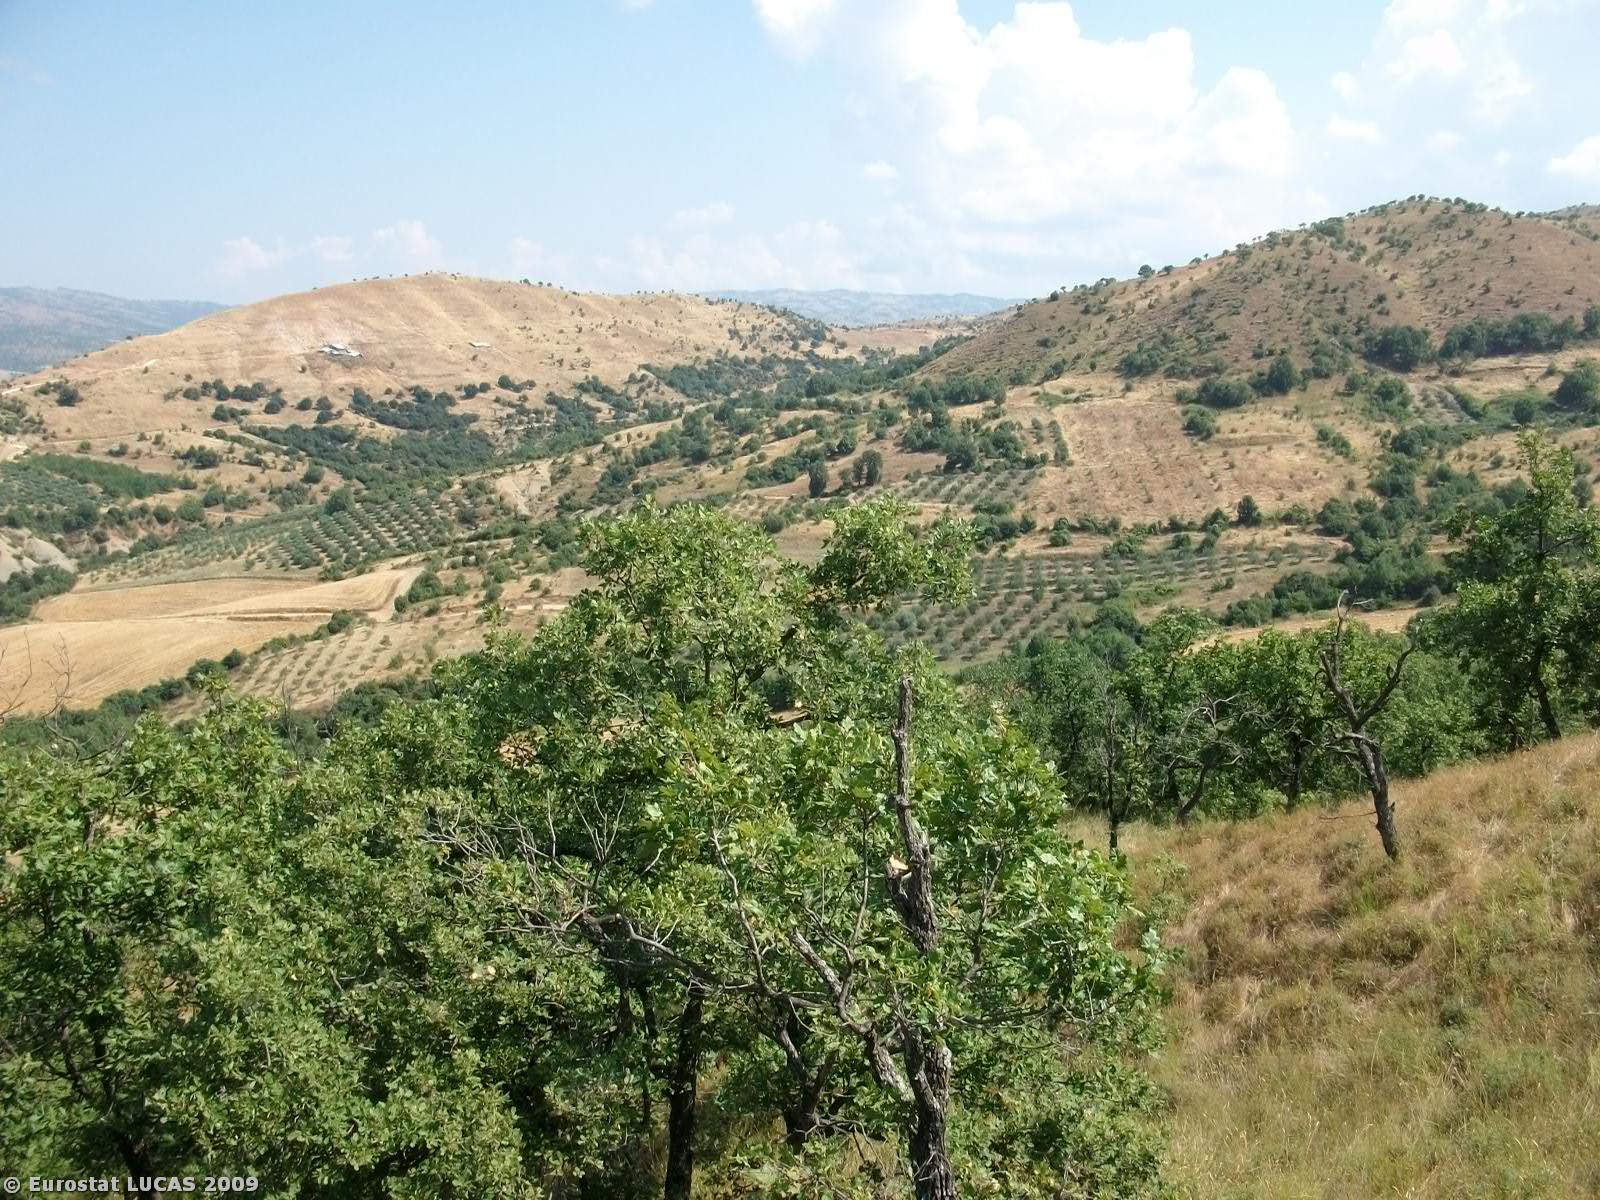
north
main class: Grassland
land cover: Grassland with sparse tree/shrub cover
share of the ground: > 75 %
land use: Agriculture (excluding fallow land and kitchen gardens)
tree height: < 5 m
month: July
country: GR
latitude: 39.6893
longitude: 21.7268
